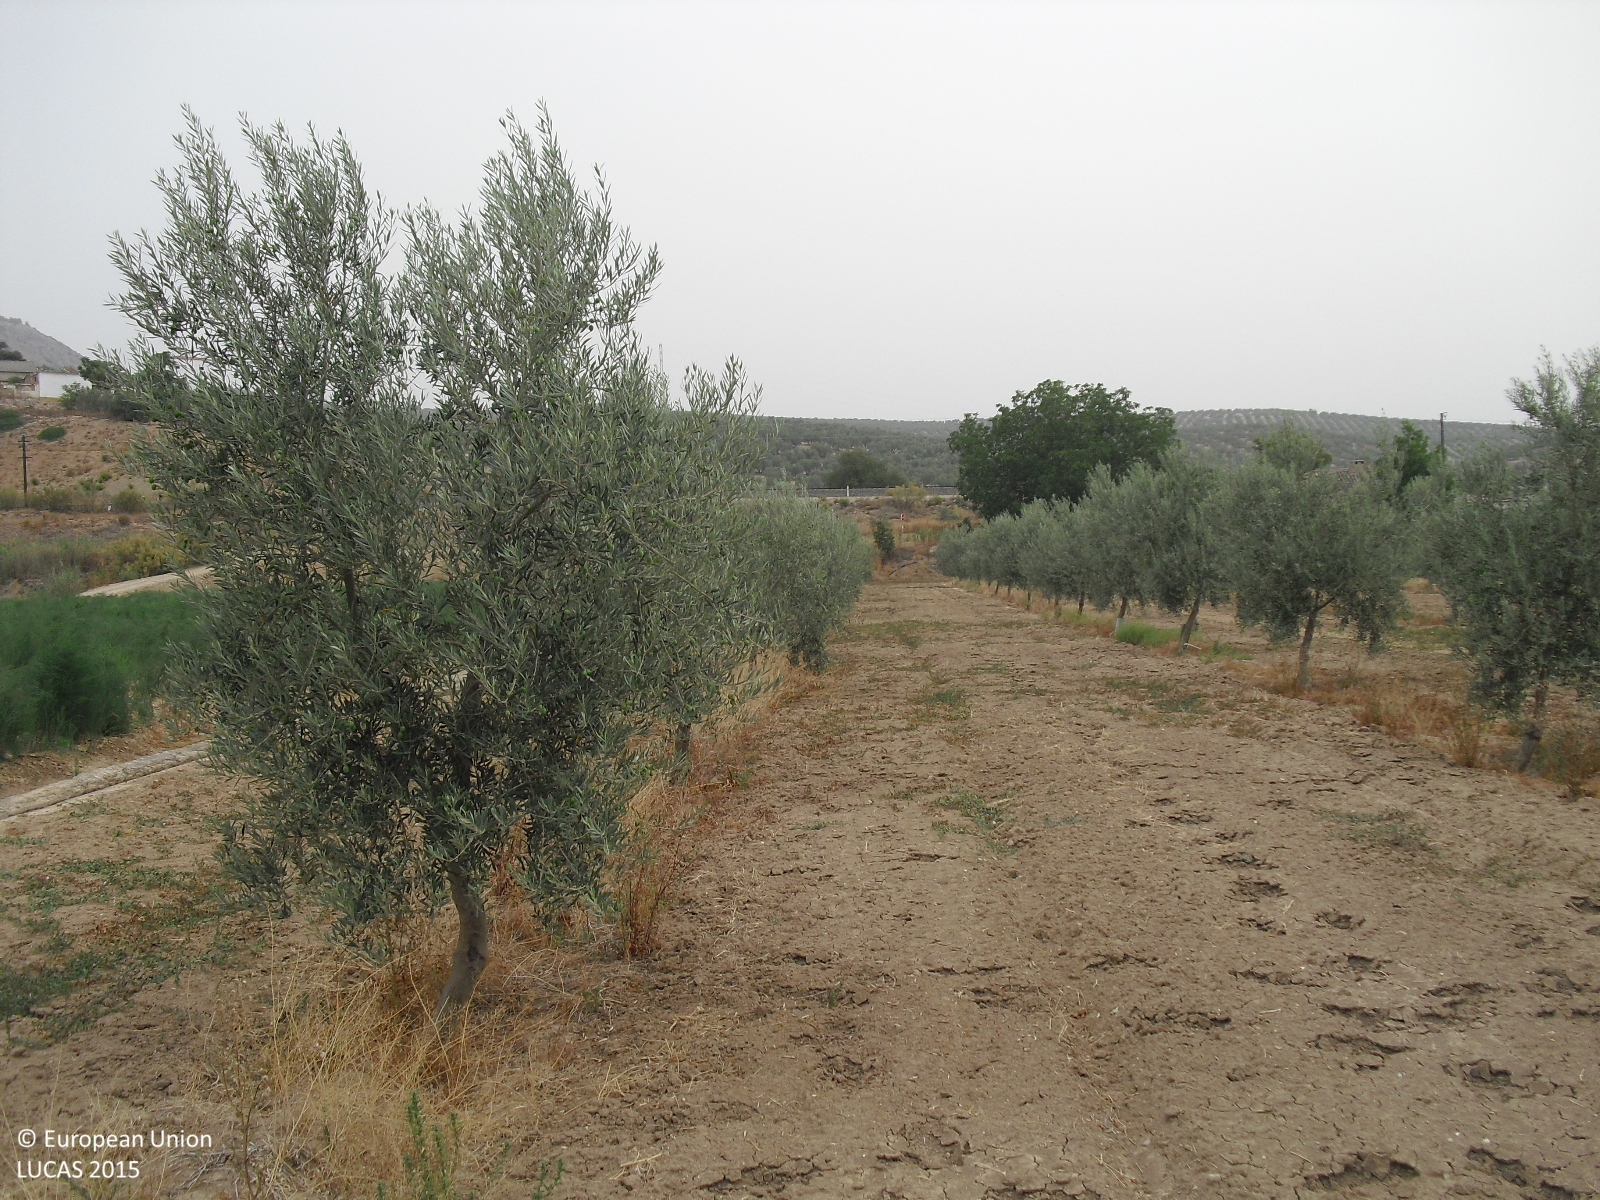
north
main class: Cropland
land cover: Olive groves
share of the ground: < 10 %
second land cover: Spontaneously vegetated surfaces
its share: 10 - 25 %
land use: Agriculture (excluding fallow land and kitchen gardens)
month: August
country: ES
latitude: 37.1683
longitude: -4.1053
